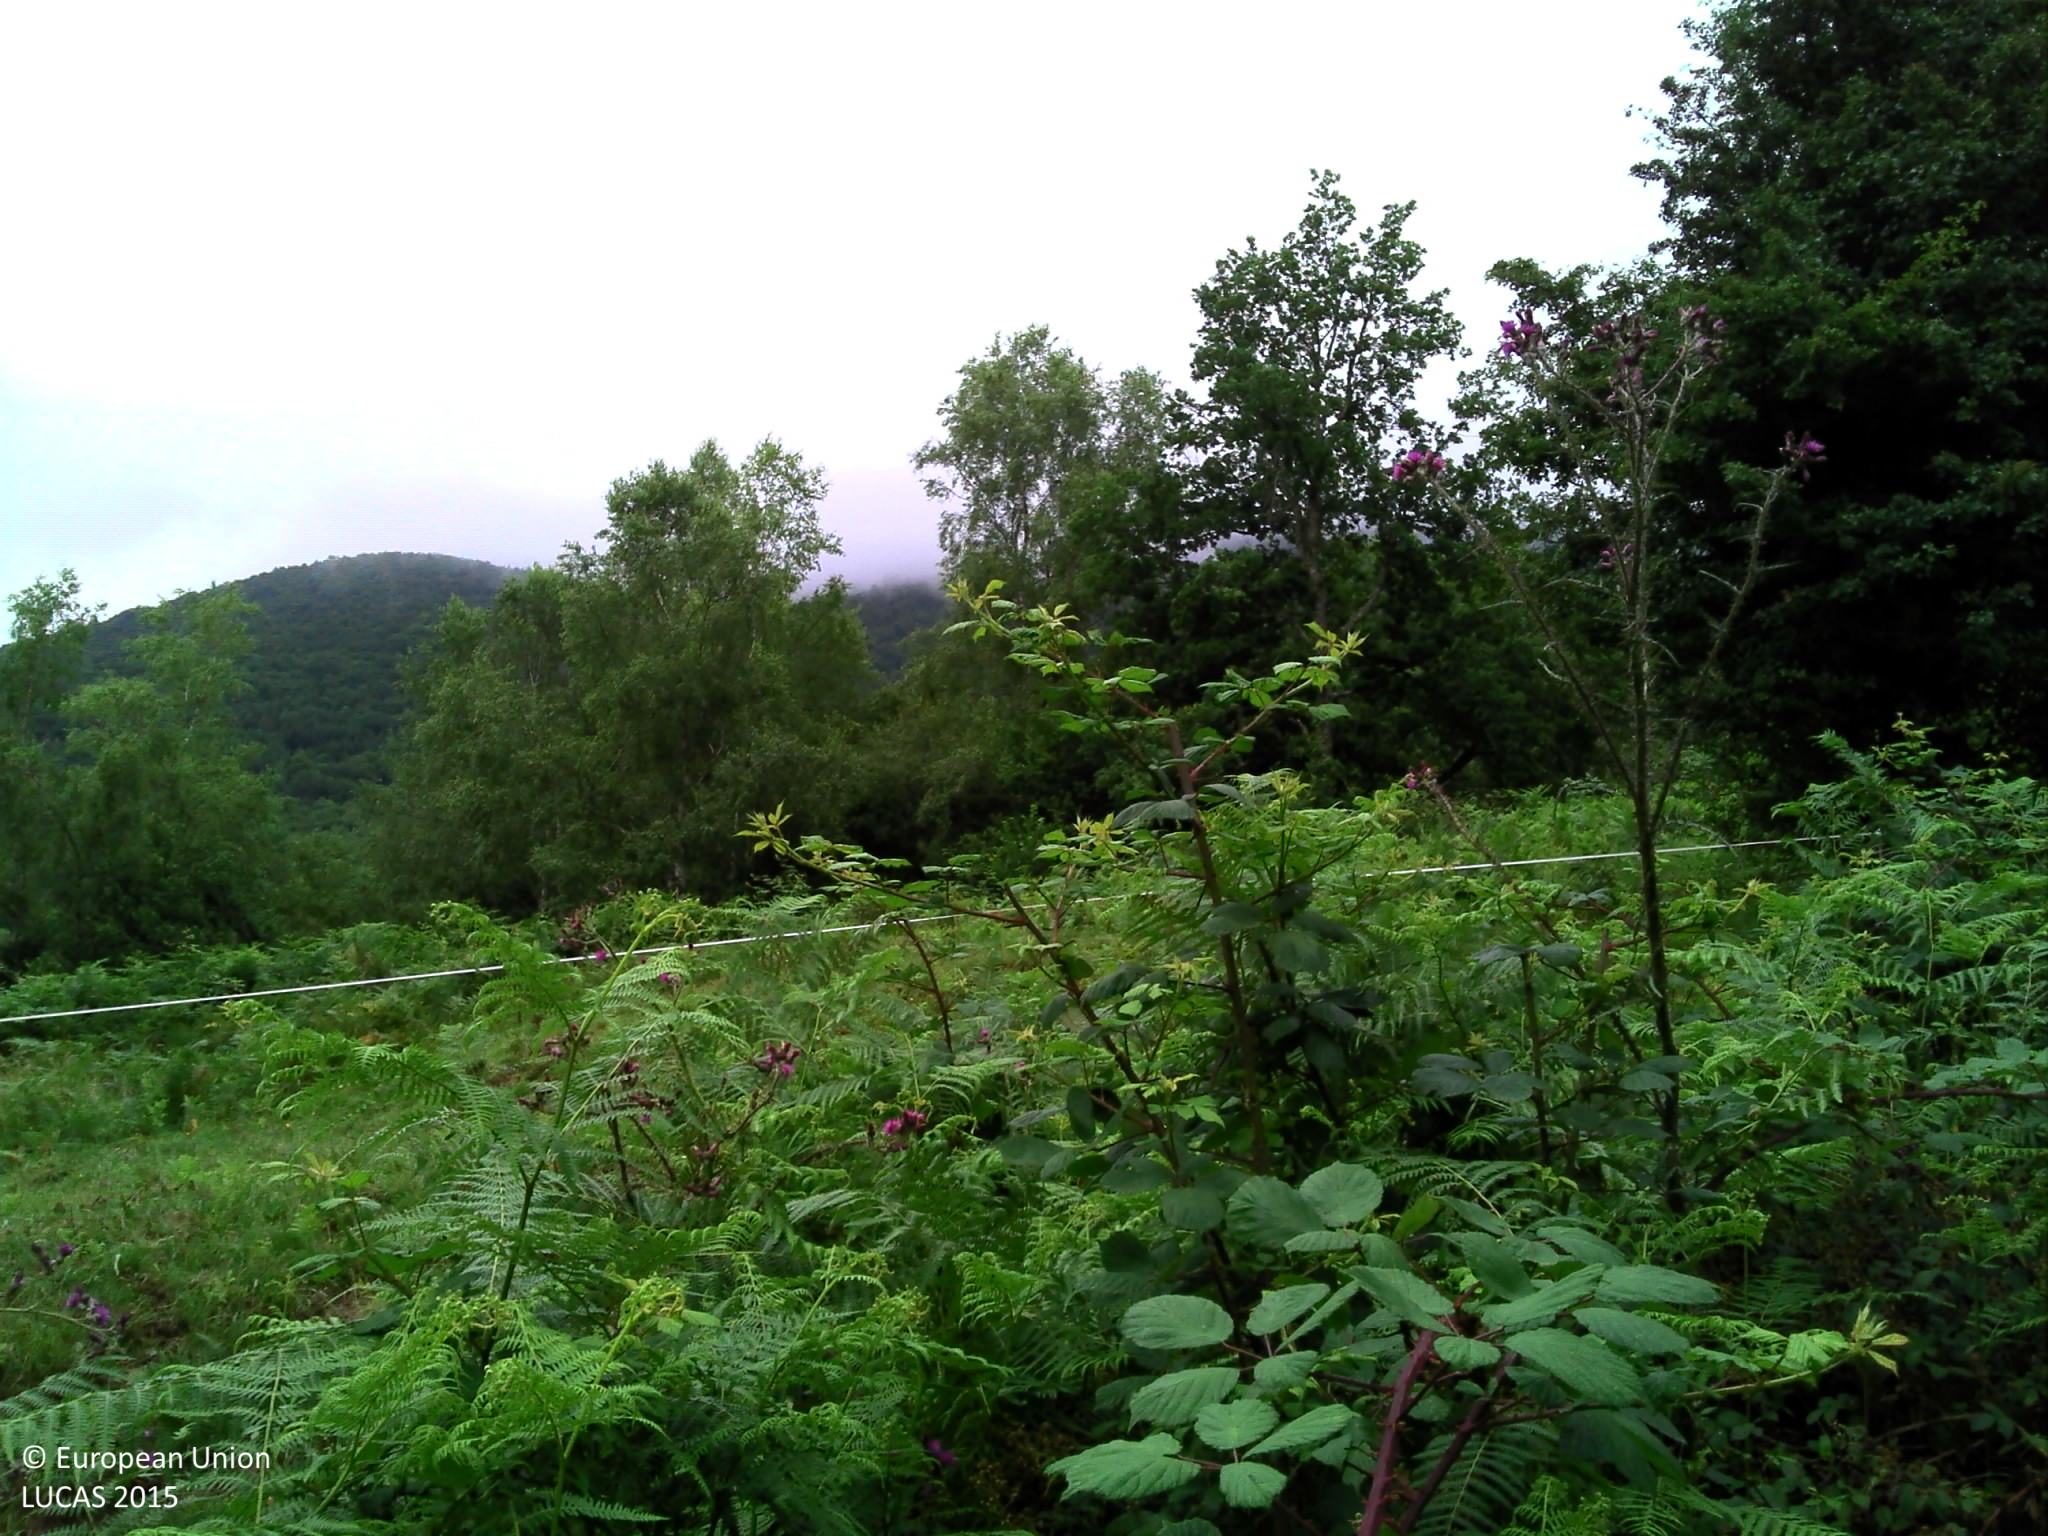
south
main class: Grassland
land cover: Grassland with sparse tree/shrub cover
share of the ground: > 75 %
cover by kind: herbaceous plants 90 %, broadleaved forest trees 5 %, shrubs 5 %
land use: Agriculture (excluding fallow land and kitchen gardens)
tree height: > 5 m
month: July
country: FR
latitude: 42.8835
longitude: 1.1533
